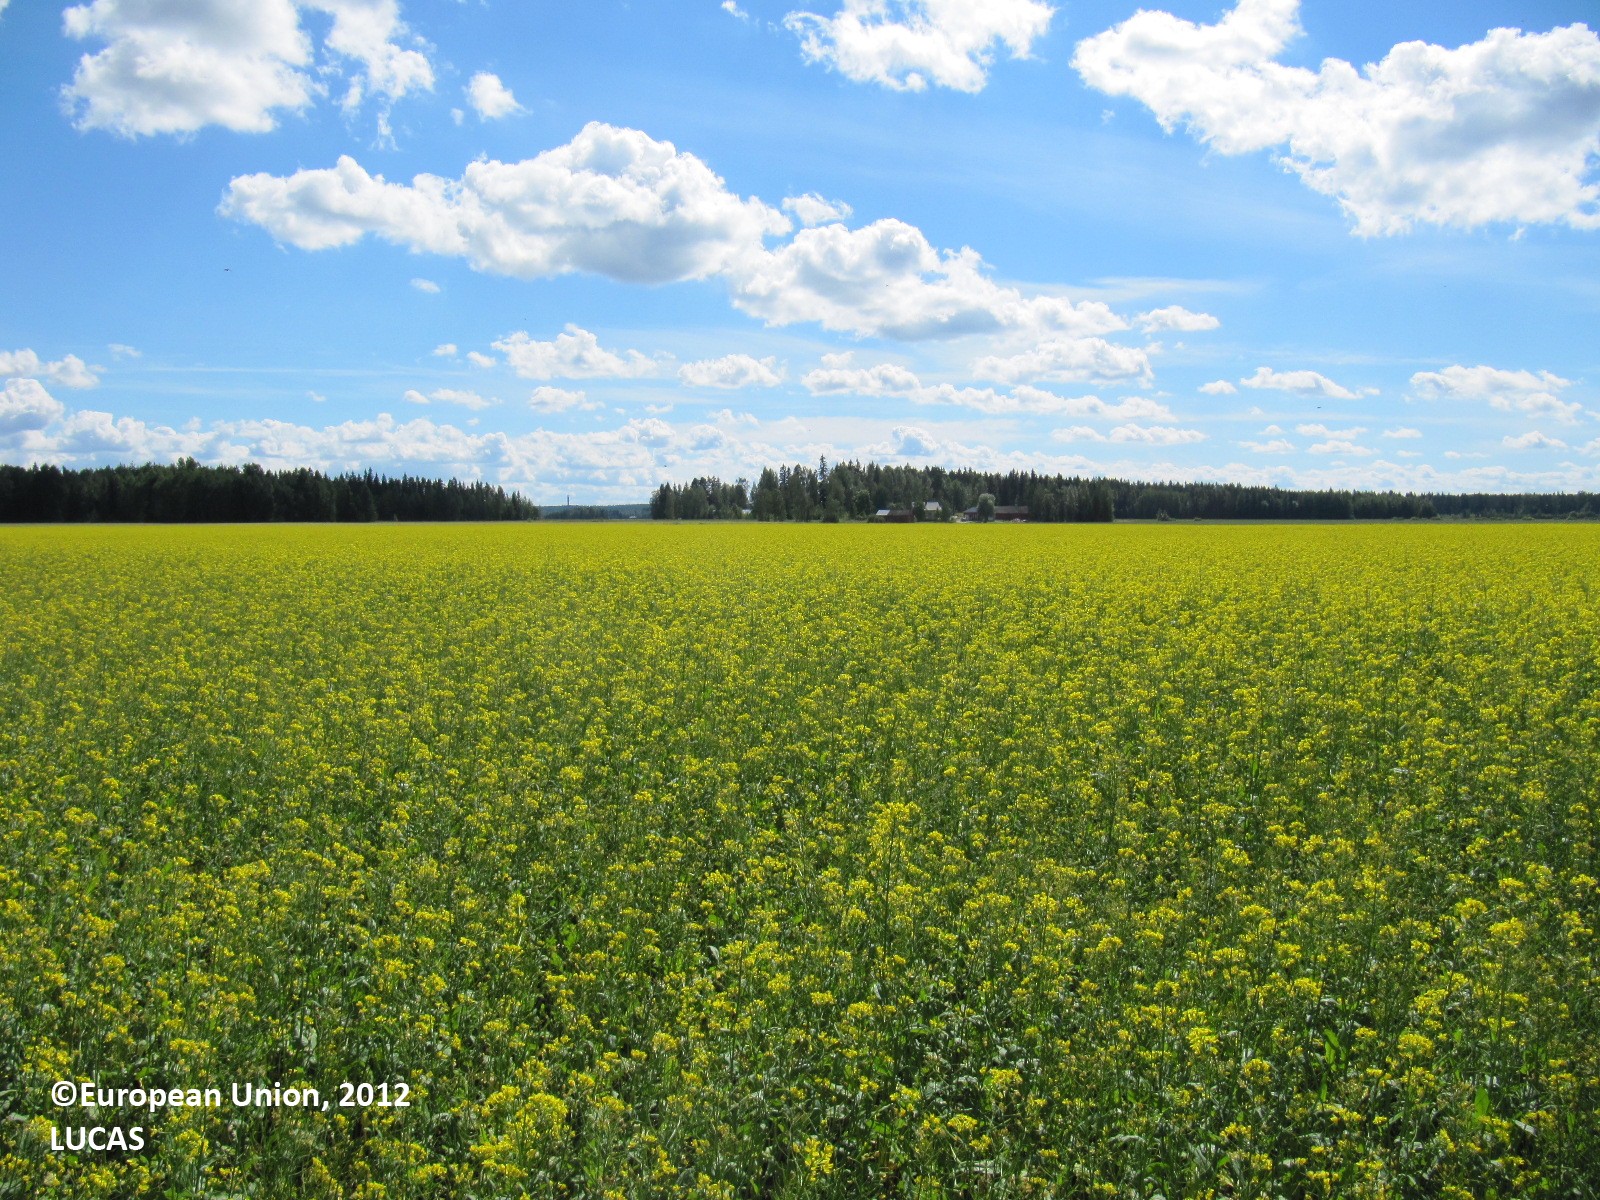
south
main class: Cropland
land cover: Rape and turnip rape
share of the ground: > 75 %
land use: Agriculture (excluding fallow land and kitchen gardens)
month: August
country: FI
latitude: 60.6338
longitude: 23.2249
